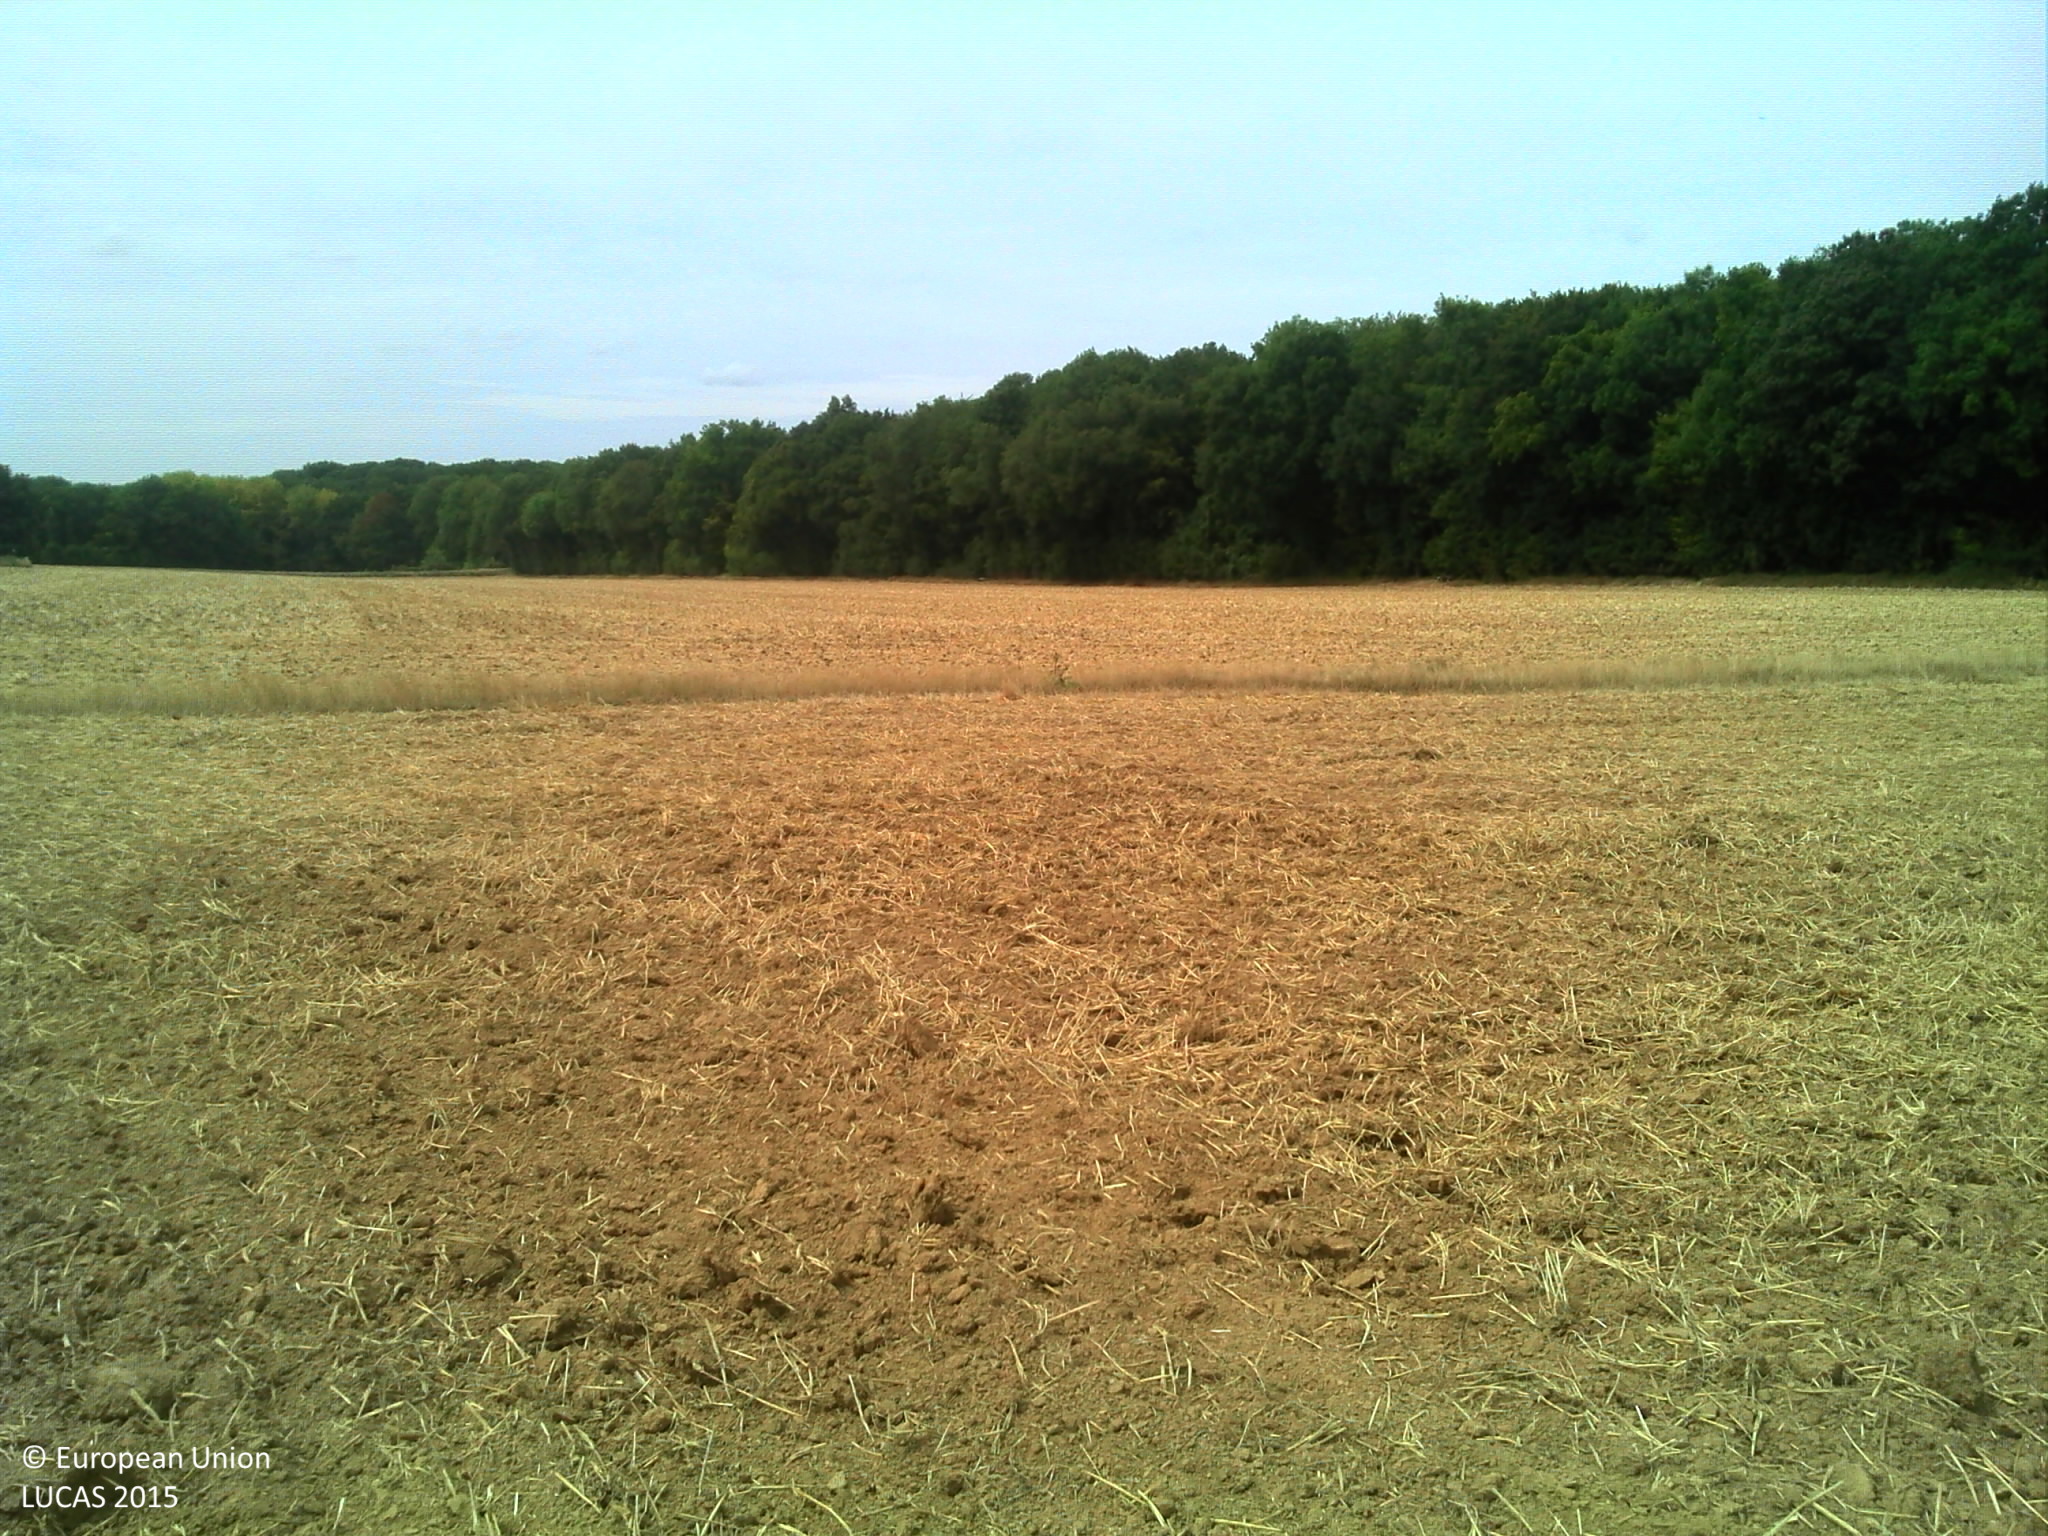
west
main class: Cropland
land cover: Common wheat
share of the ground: < 10 %
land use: Agriculture (excluding fallow land and kitchen gardens)
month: August
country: FR
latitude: 49.1692
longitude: 1.8511
